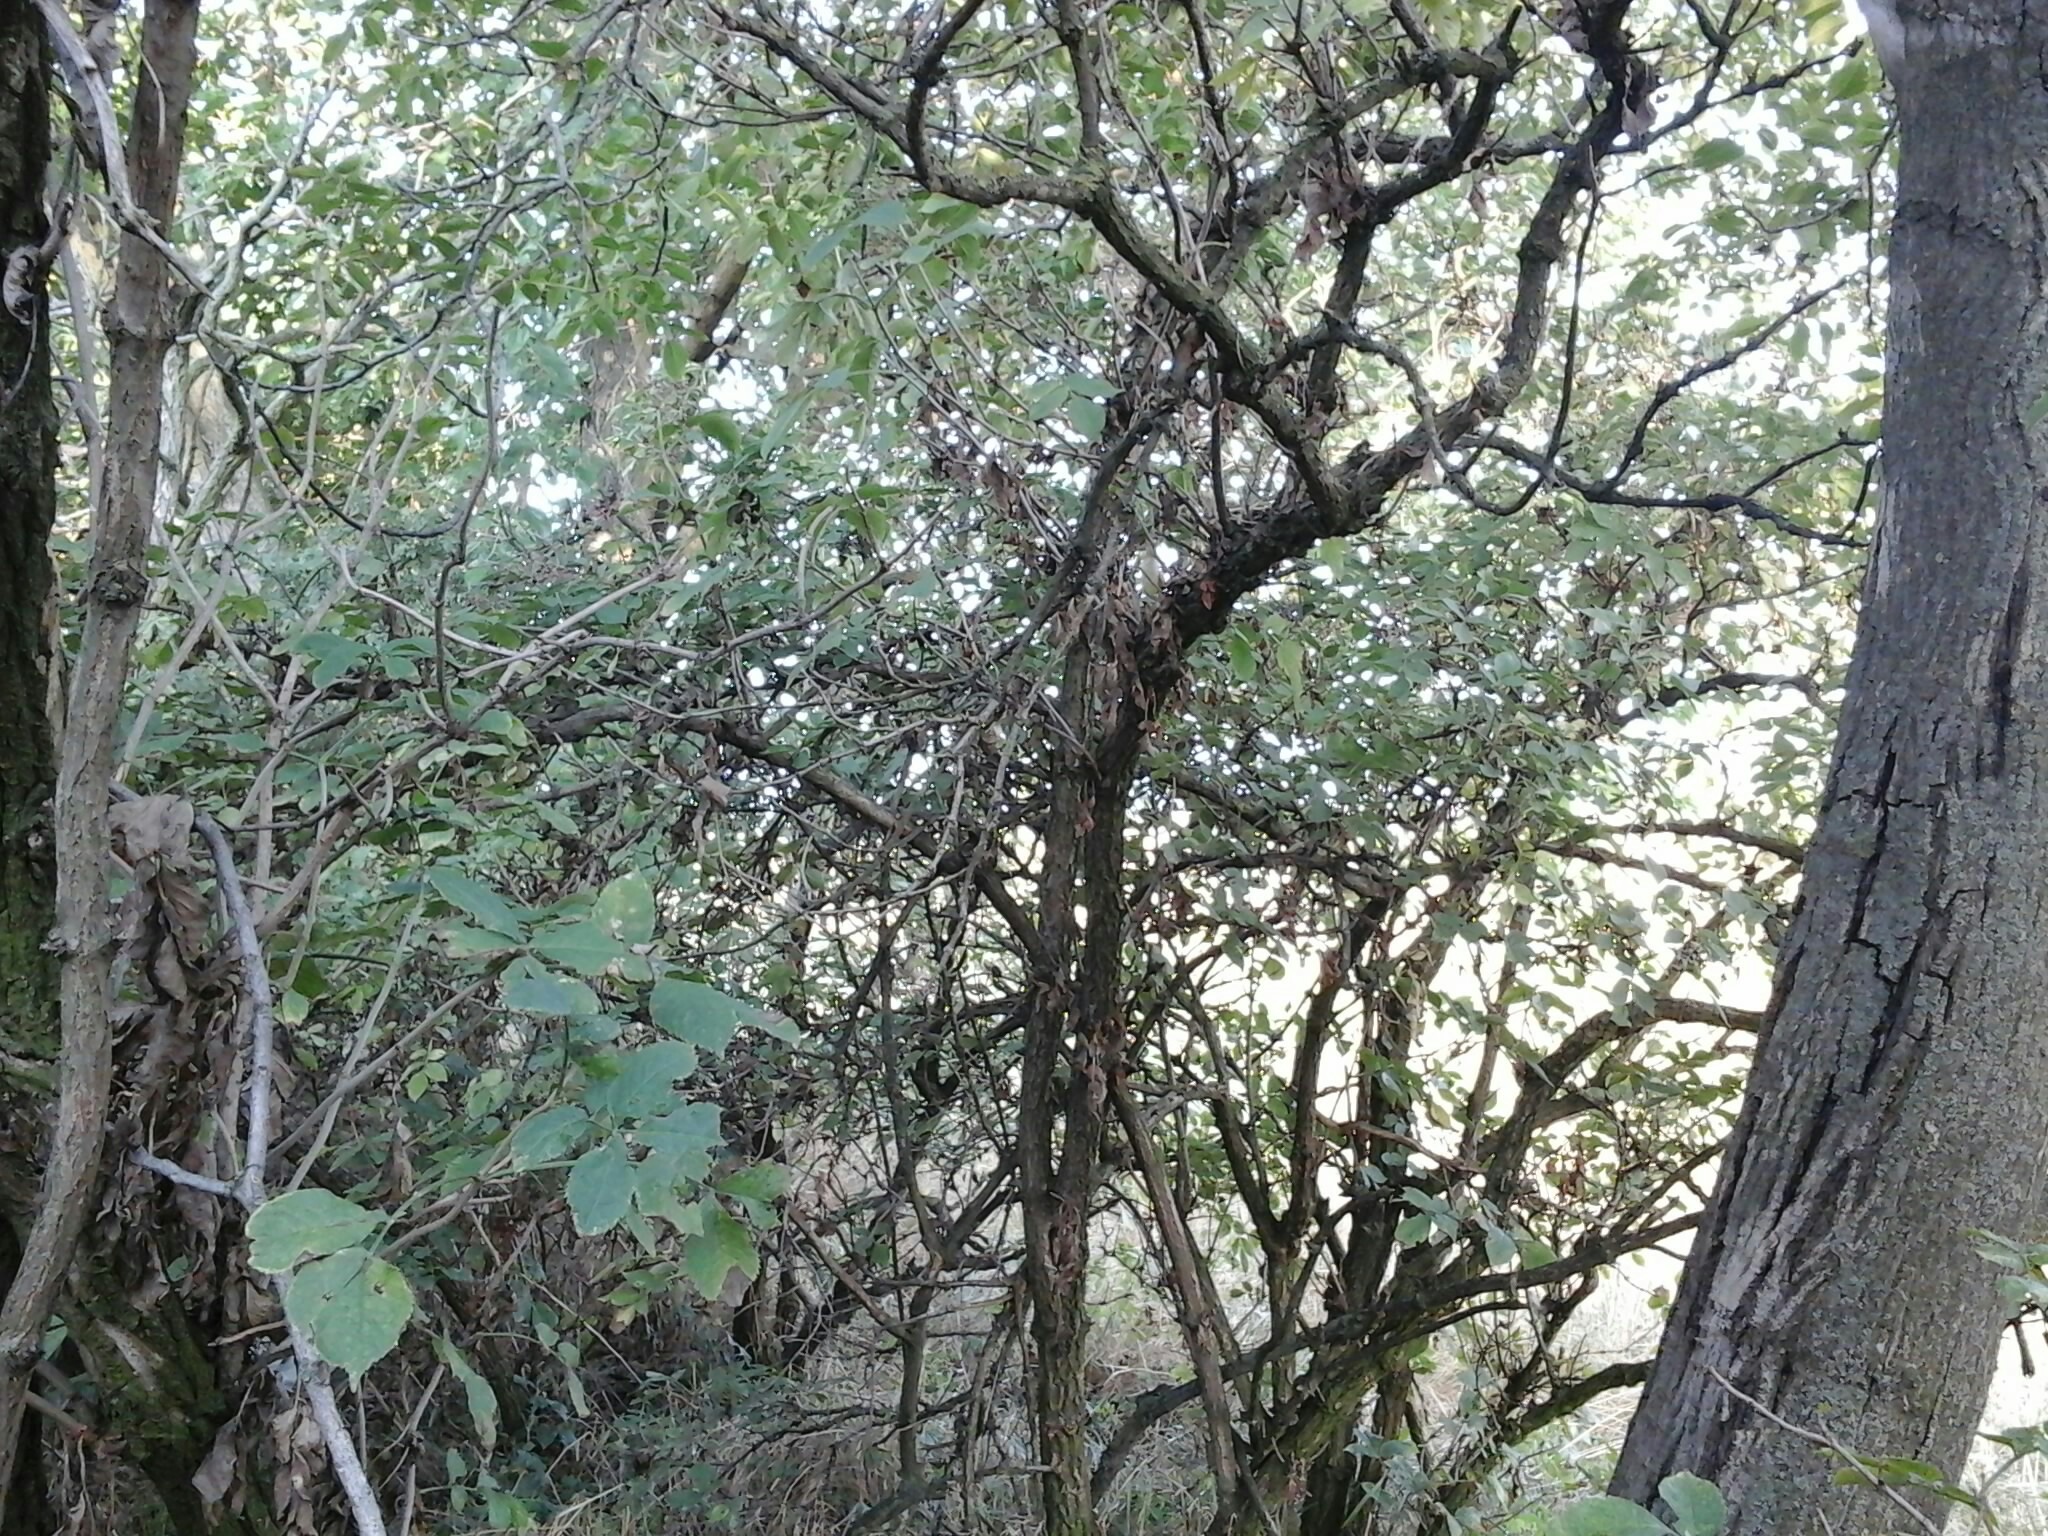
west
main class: Woodland
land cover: Broadleaved woodland
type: mesophytic deciduous forest
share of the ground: > 75 %
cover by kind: broadleaved forest trees 80 %, shrubs 15 %, herbaceous plants 5 %
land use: Semi-natural and natural areas not in use
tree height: > 5 m
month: August
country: HU
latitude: 47.6583
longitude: 18.0405
